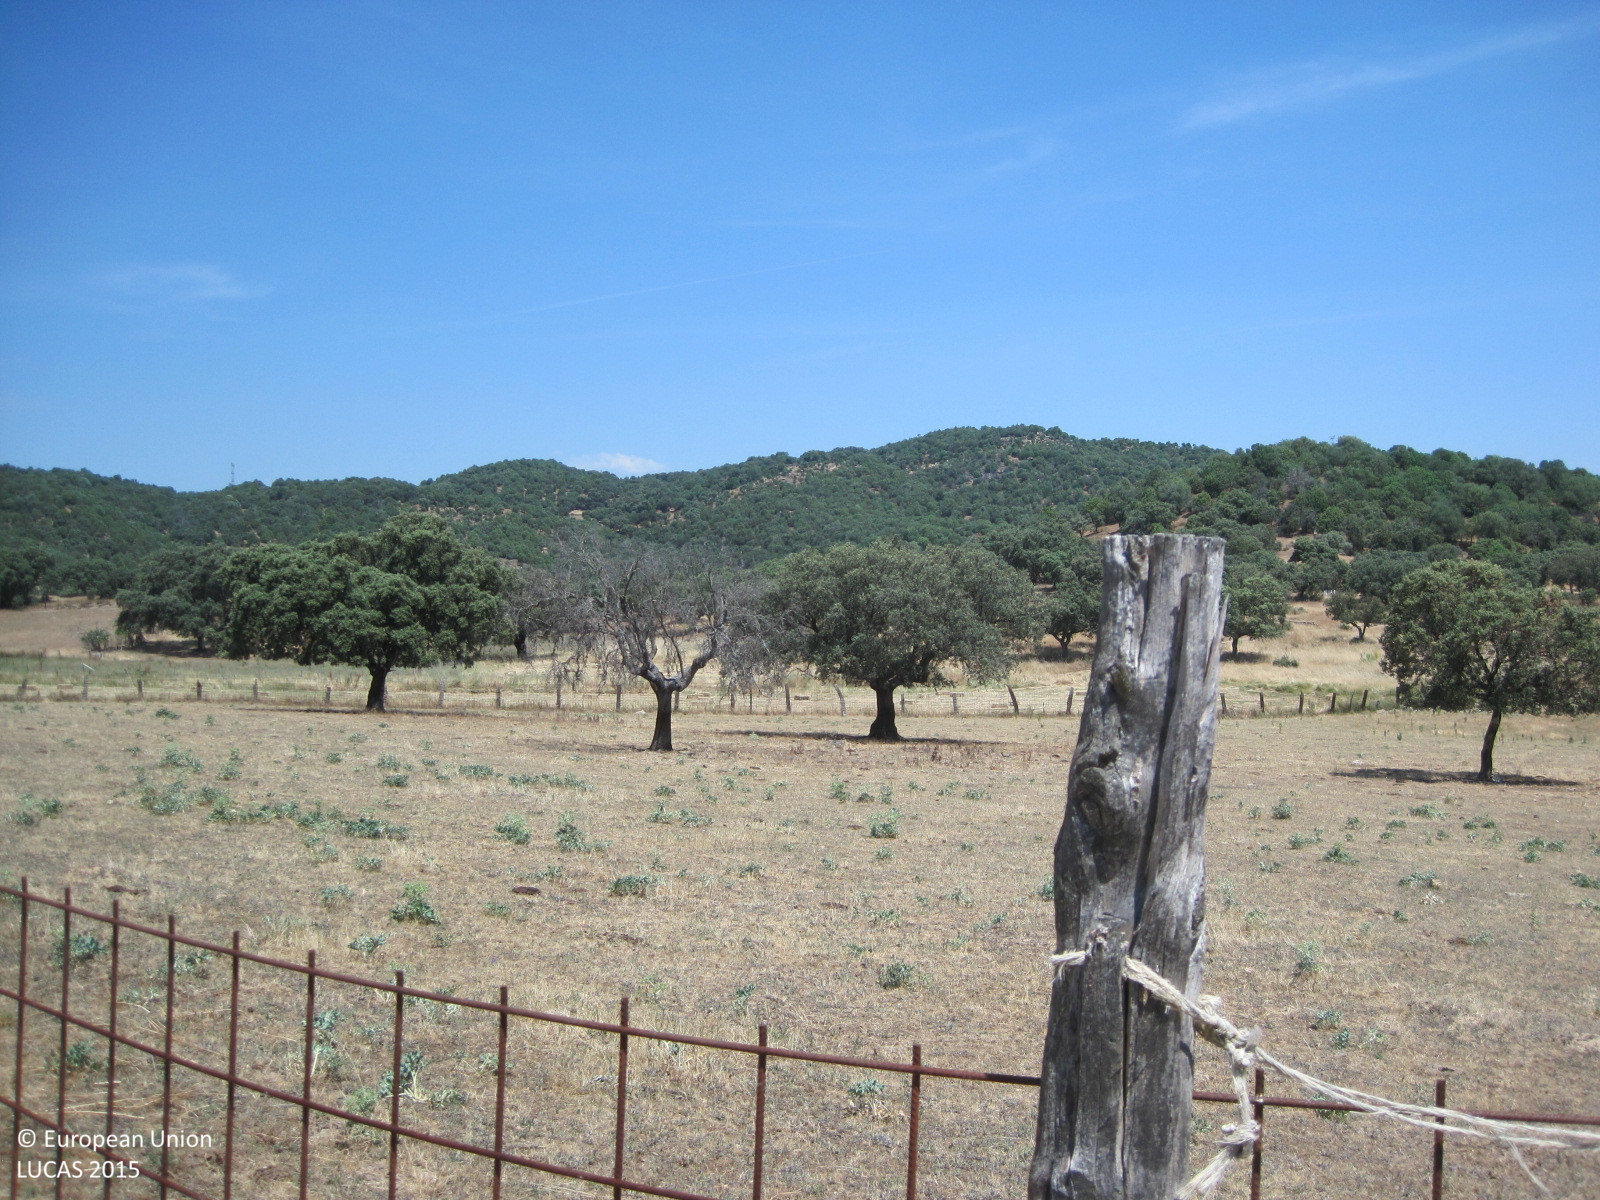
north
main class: Woodland
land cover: Broadleaved woodland
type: broadleaved evergreen forest
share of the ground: 50 - 75 %
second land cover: Grassland without tree/shrub cover
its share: > 75 %
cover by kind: broadleaved forest trees 45 %, herbaceous plants 45 %, unconsolidated bare surface 10 %
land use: Forestry
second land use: Agriculture (excluding fallow land and kitchen gardens)
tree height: < 5 m
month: June
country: ES
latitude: 40.0404
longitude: -4.7804
